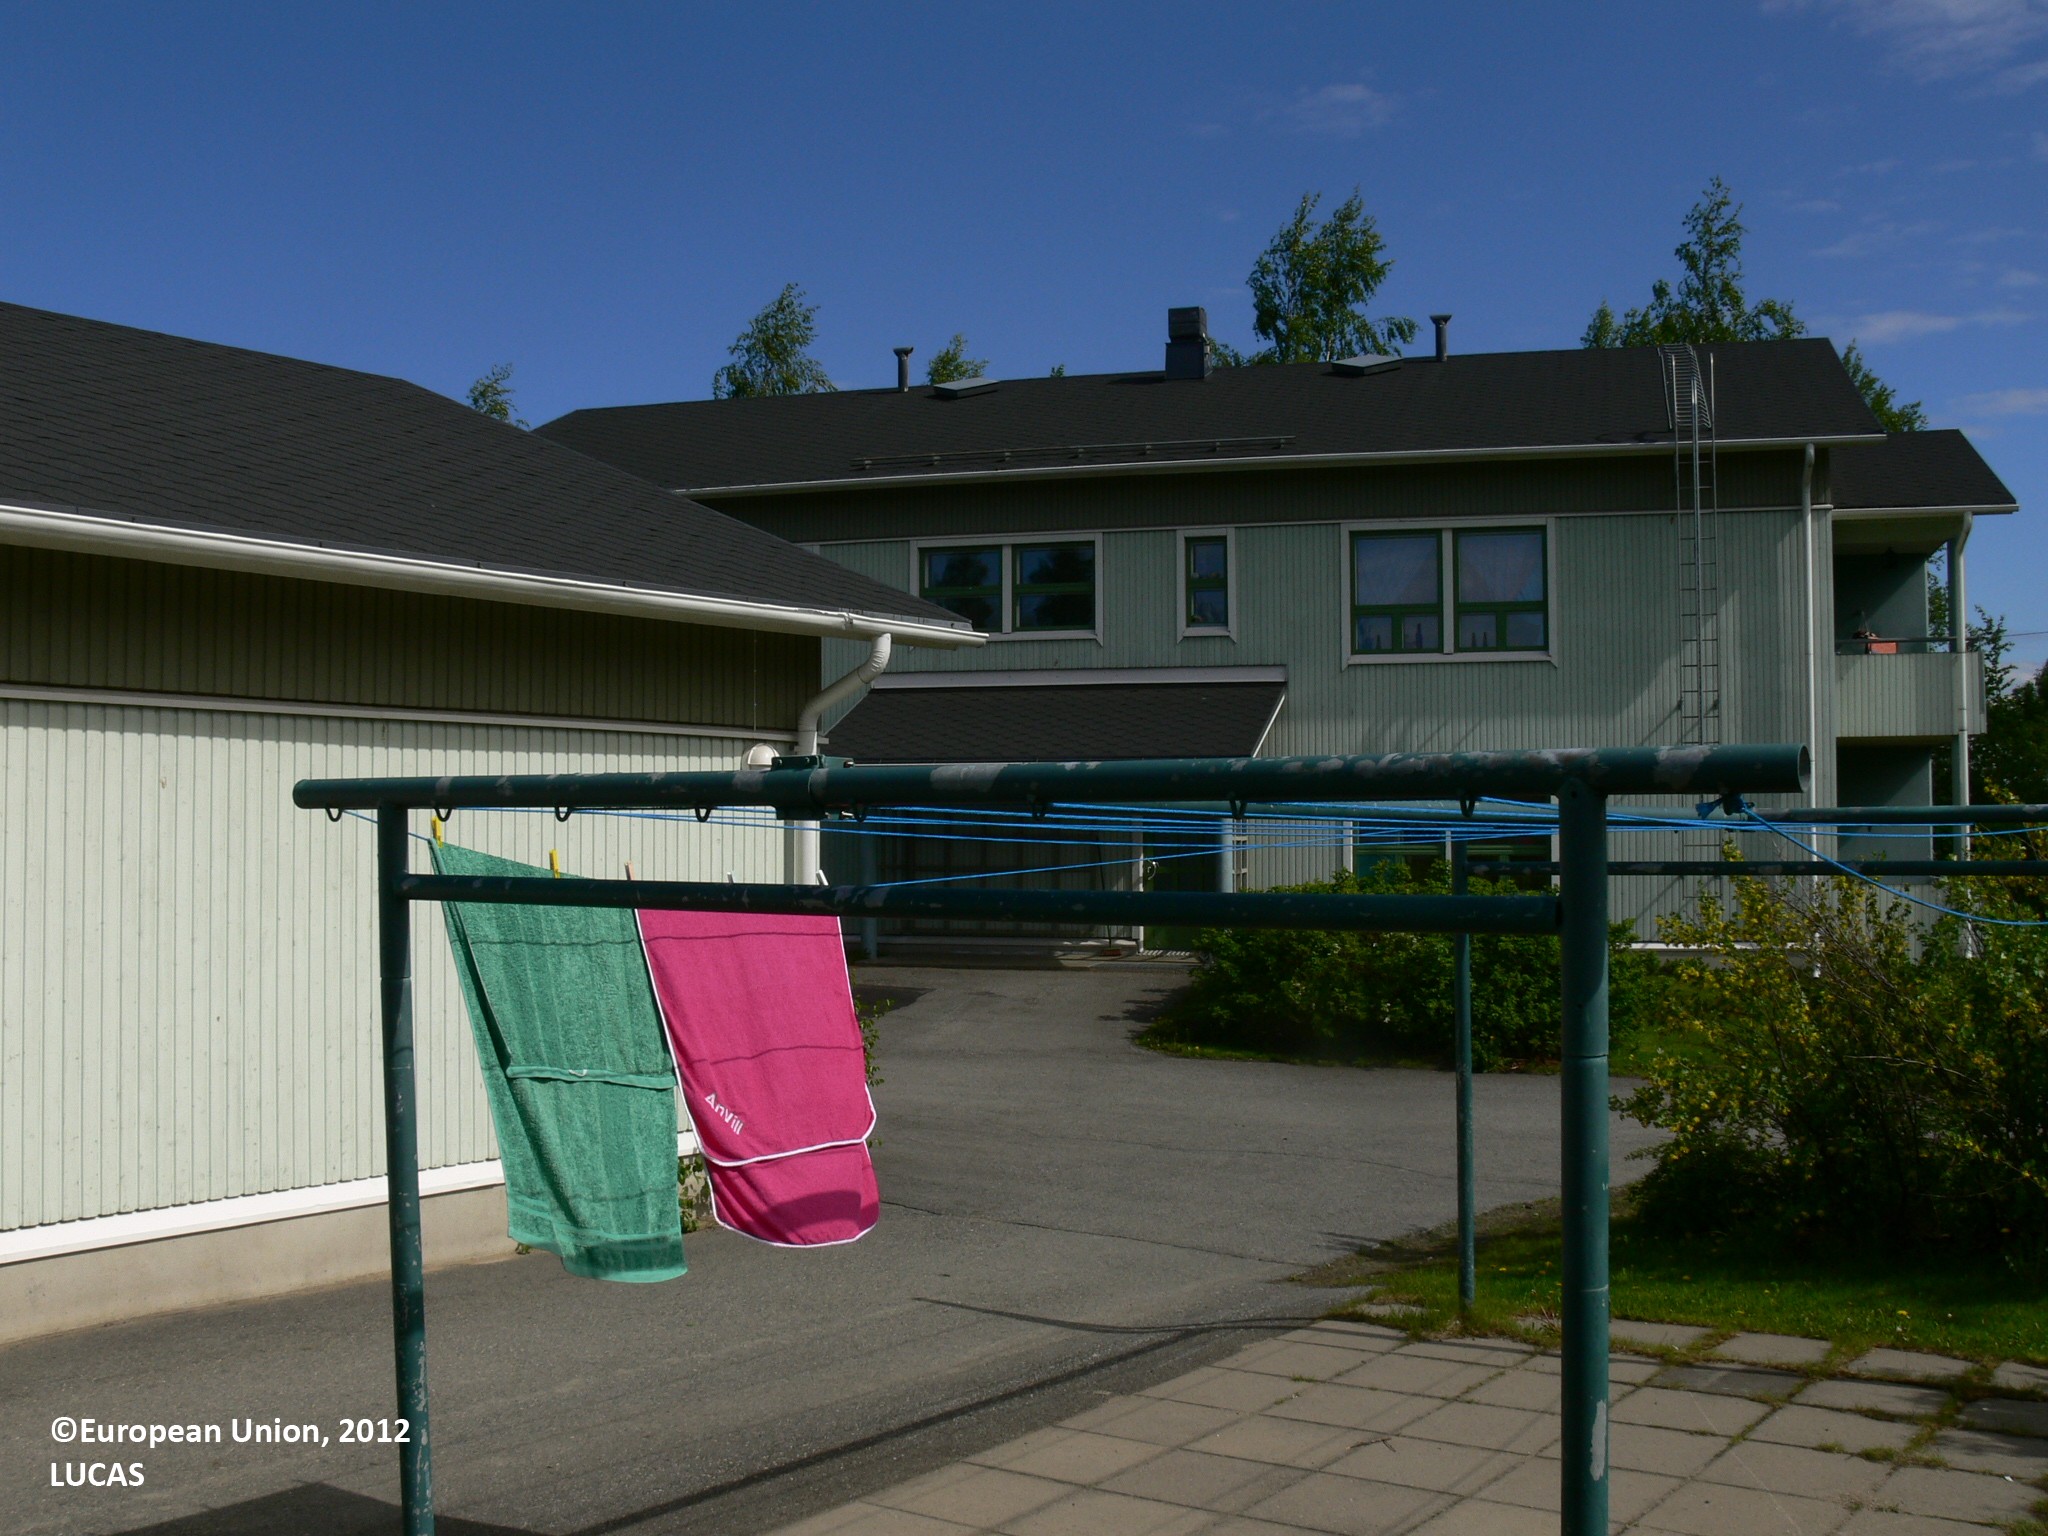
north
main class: Grassland
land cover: Grassland with sparse tree/shrub cover
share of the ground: 50 - 75 %
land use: Residential
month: June
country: FI
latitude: 62.5996
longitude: 29.8268
